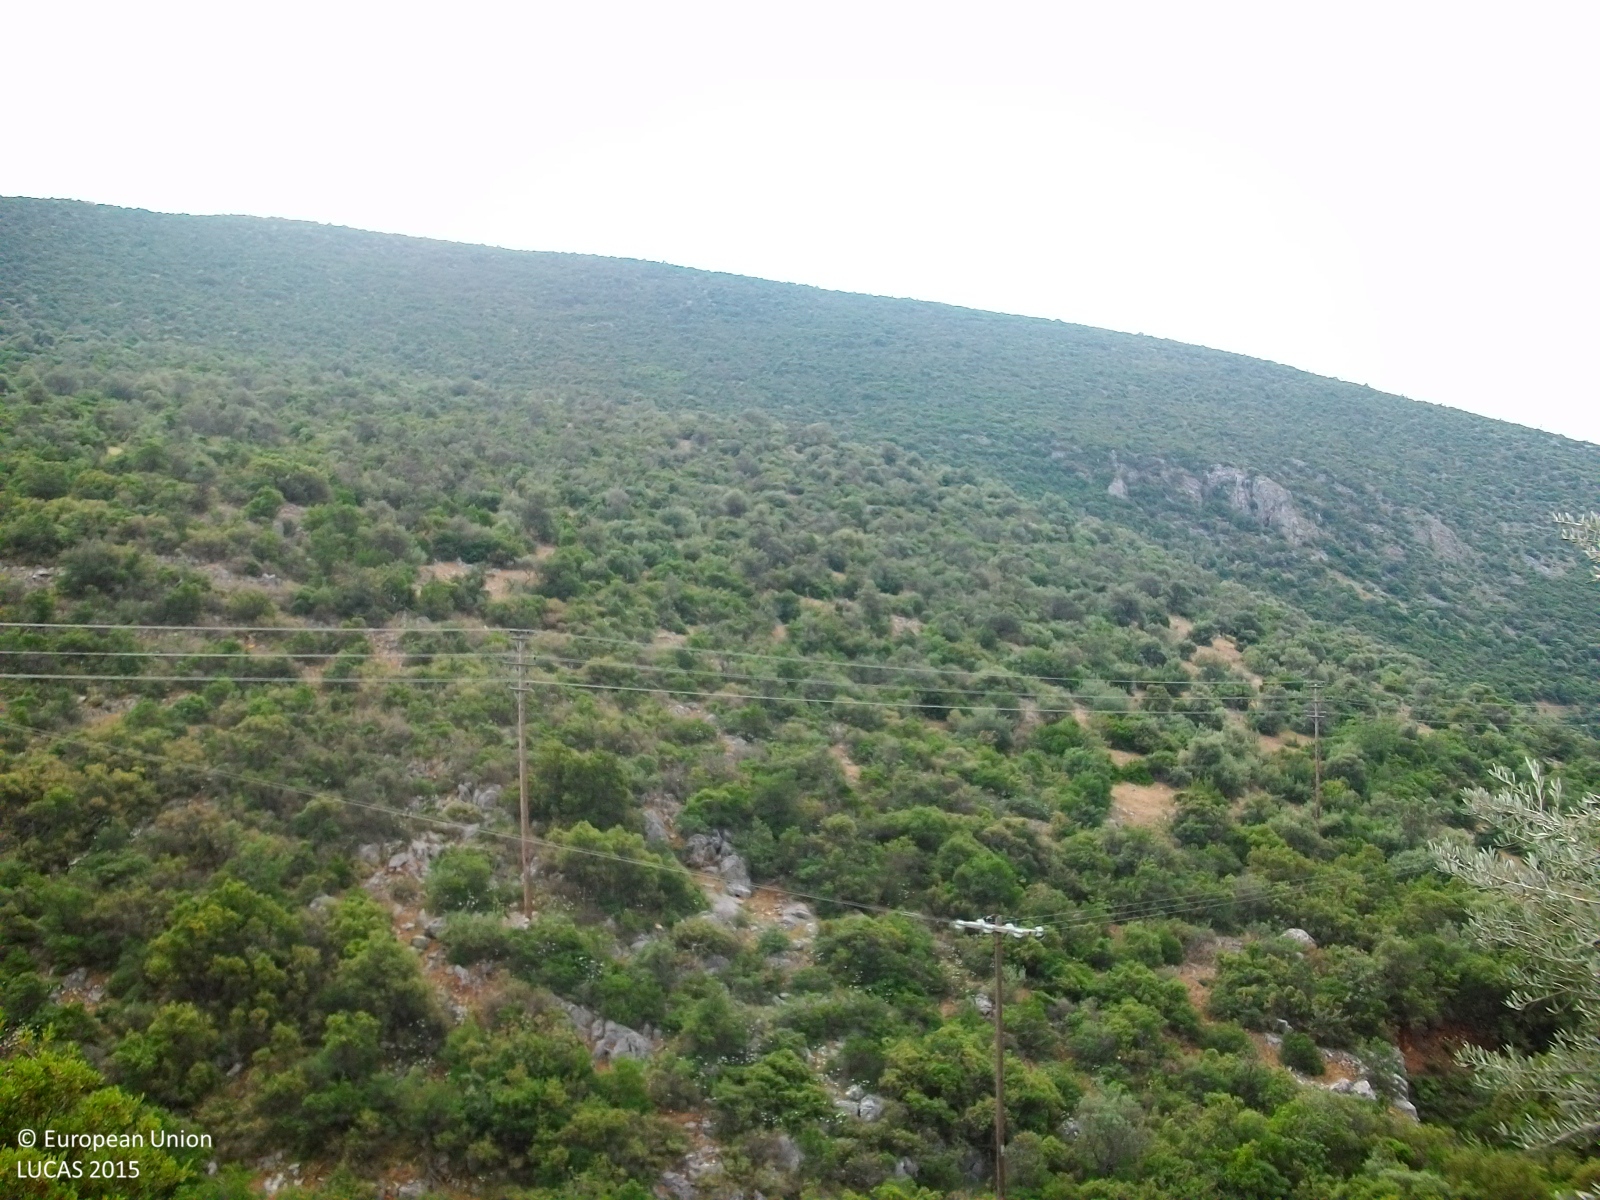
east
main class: Shrubland
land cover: Shrubland with sparse tree cover
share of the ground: > 75 %
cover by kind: shrubs 95 %, broadleaved forest trees 5 %
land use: Semi-natural and natural areas not in use
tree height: < 5 m
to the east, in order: Shrubland with sparse tree cover; Grassland with sparse tree/shrub cover; Shrubland without tree cover
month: May
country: GR
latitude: 38.9402
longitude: 22.5925
